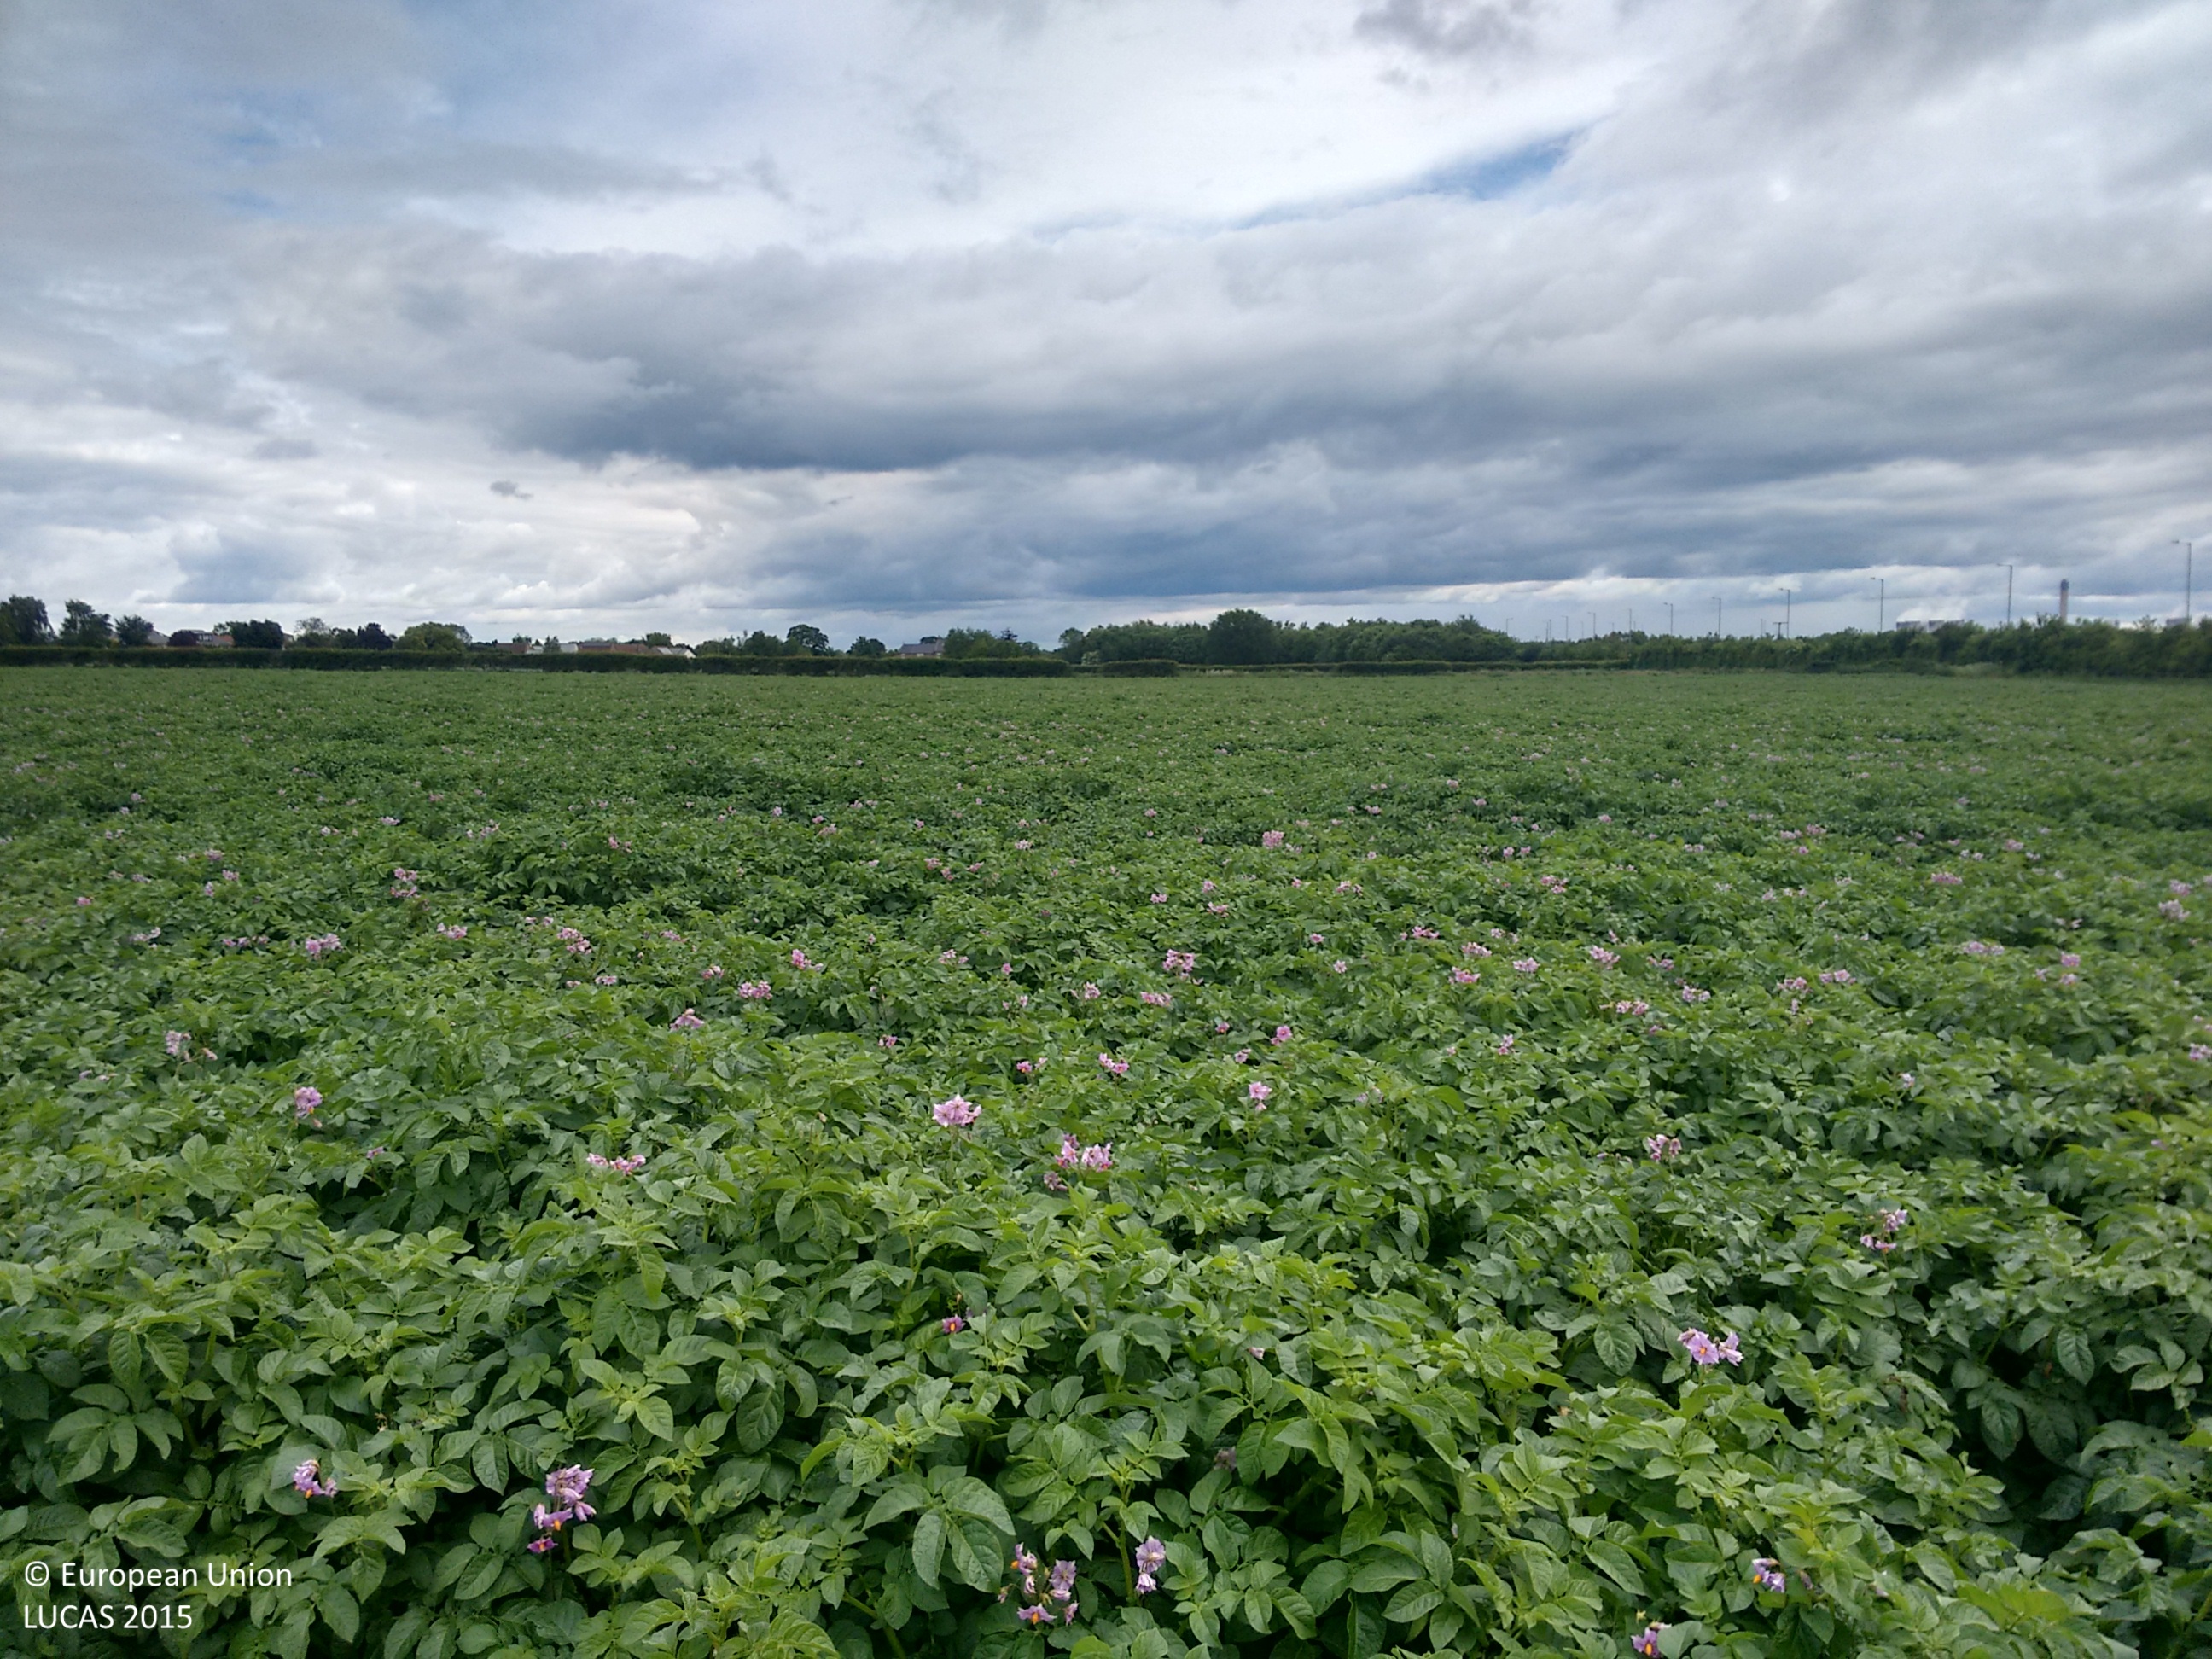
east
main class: Cropland
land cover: Potatoes
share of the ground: > 75 %
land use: Agriculture (excluding fallow land and kitchen gardens)
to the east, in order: Potatoes; Grass margins; Managed hedges; Grass margins; Common wheat
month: June
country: GB
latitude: 53.7611
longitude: -1.1024
